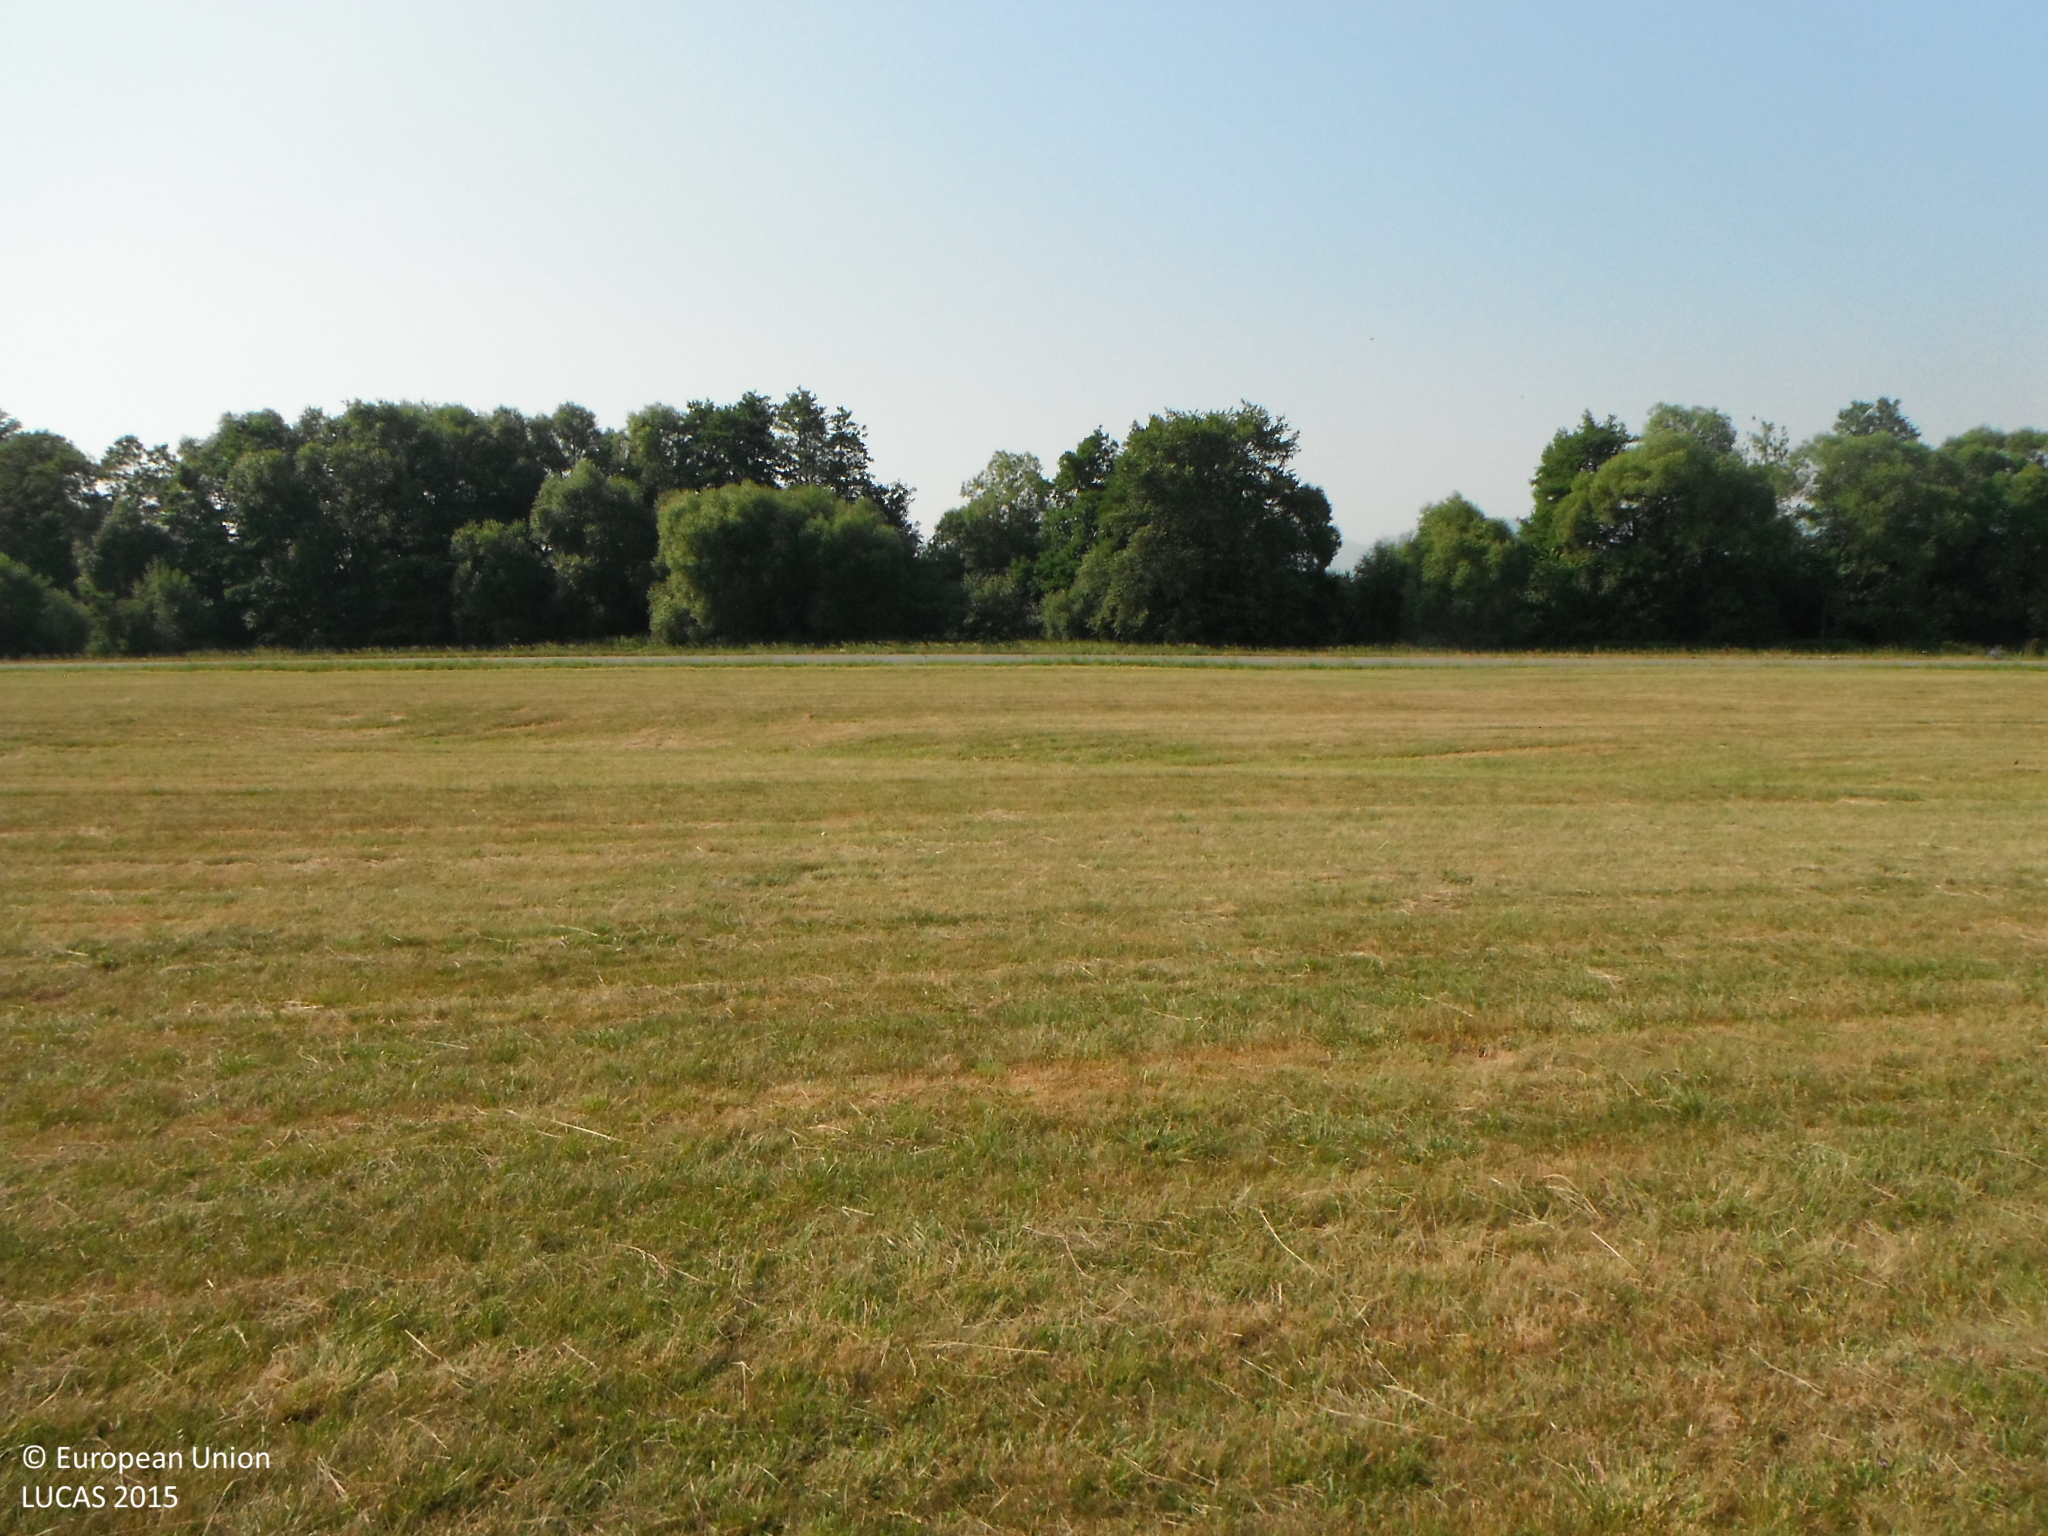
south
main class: Grassland
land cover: Grassland without tree/shrub cover
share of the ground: > 75 %
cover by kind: herbaceous plants 100 %
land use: Agriculture (excluding fallow land and kitchen gardens)
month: July
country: SK
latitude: 48.5940
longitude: 19.2565
